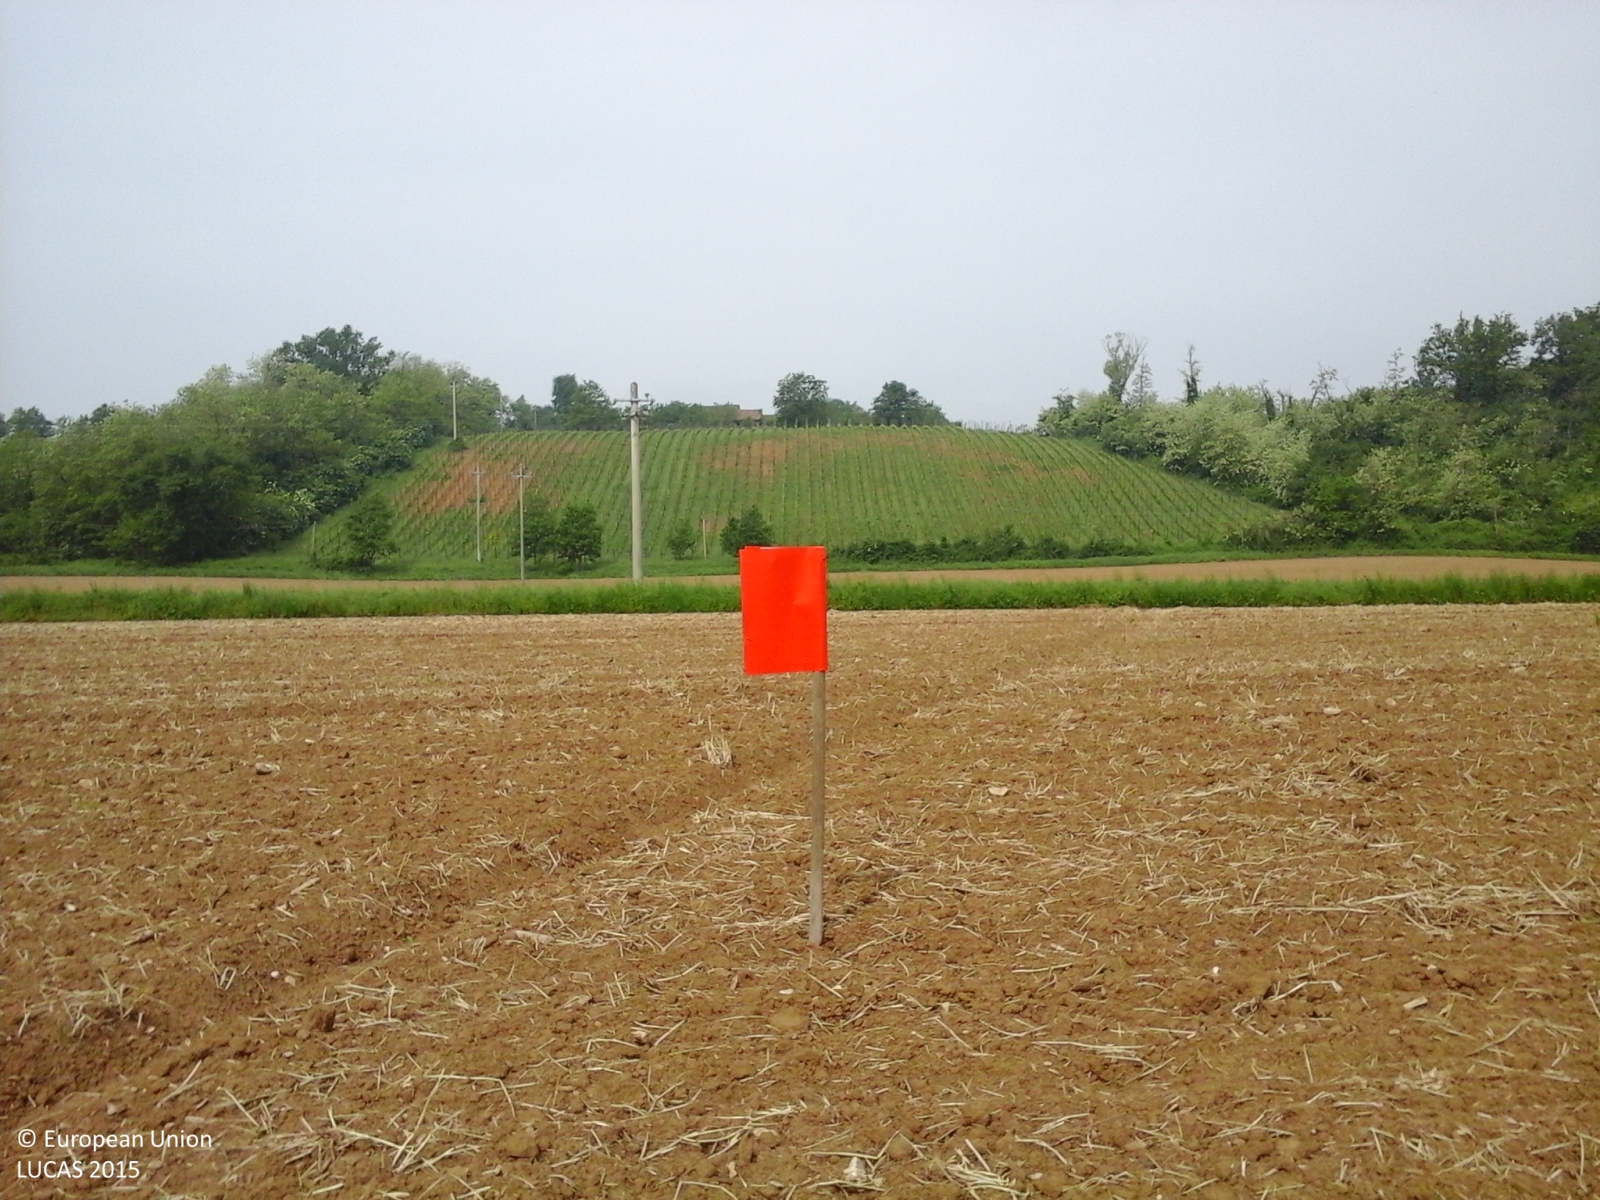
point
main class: Cropland
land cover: Maize
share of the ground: < 10 %
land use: Agriculture (excluding fallow land and kitchen gardens)
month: May
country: IT
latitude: 44.9089
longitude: 9.6334
